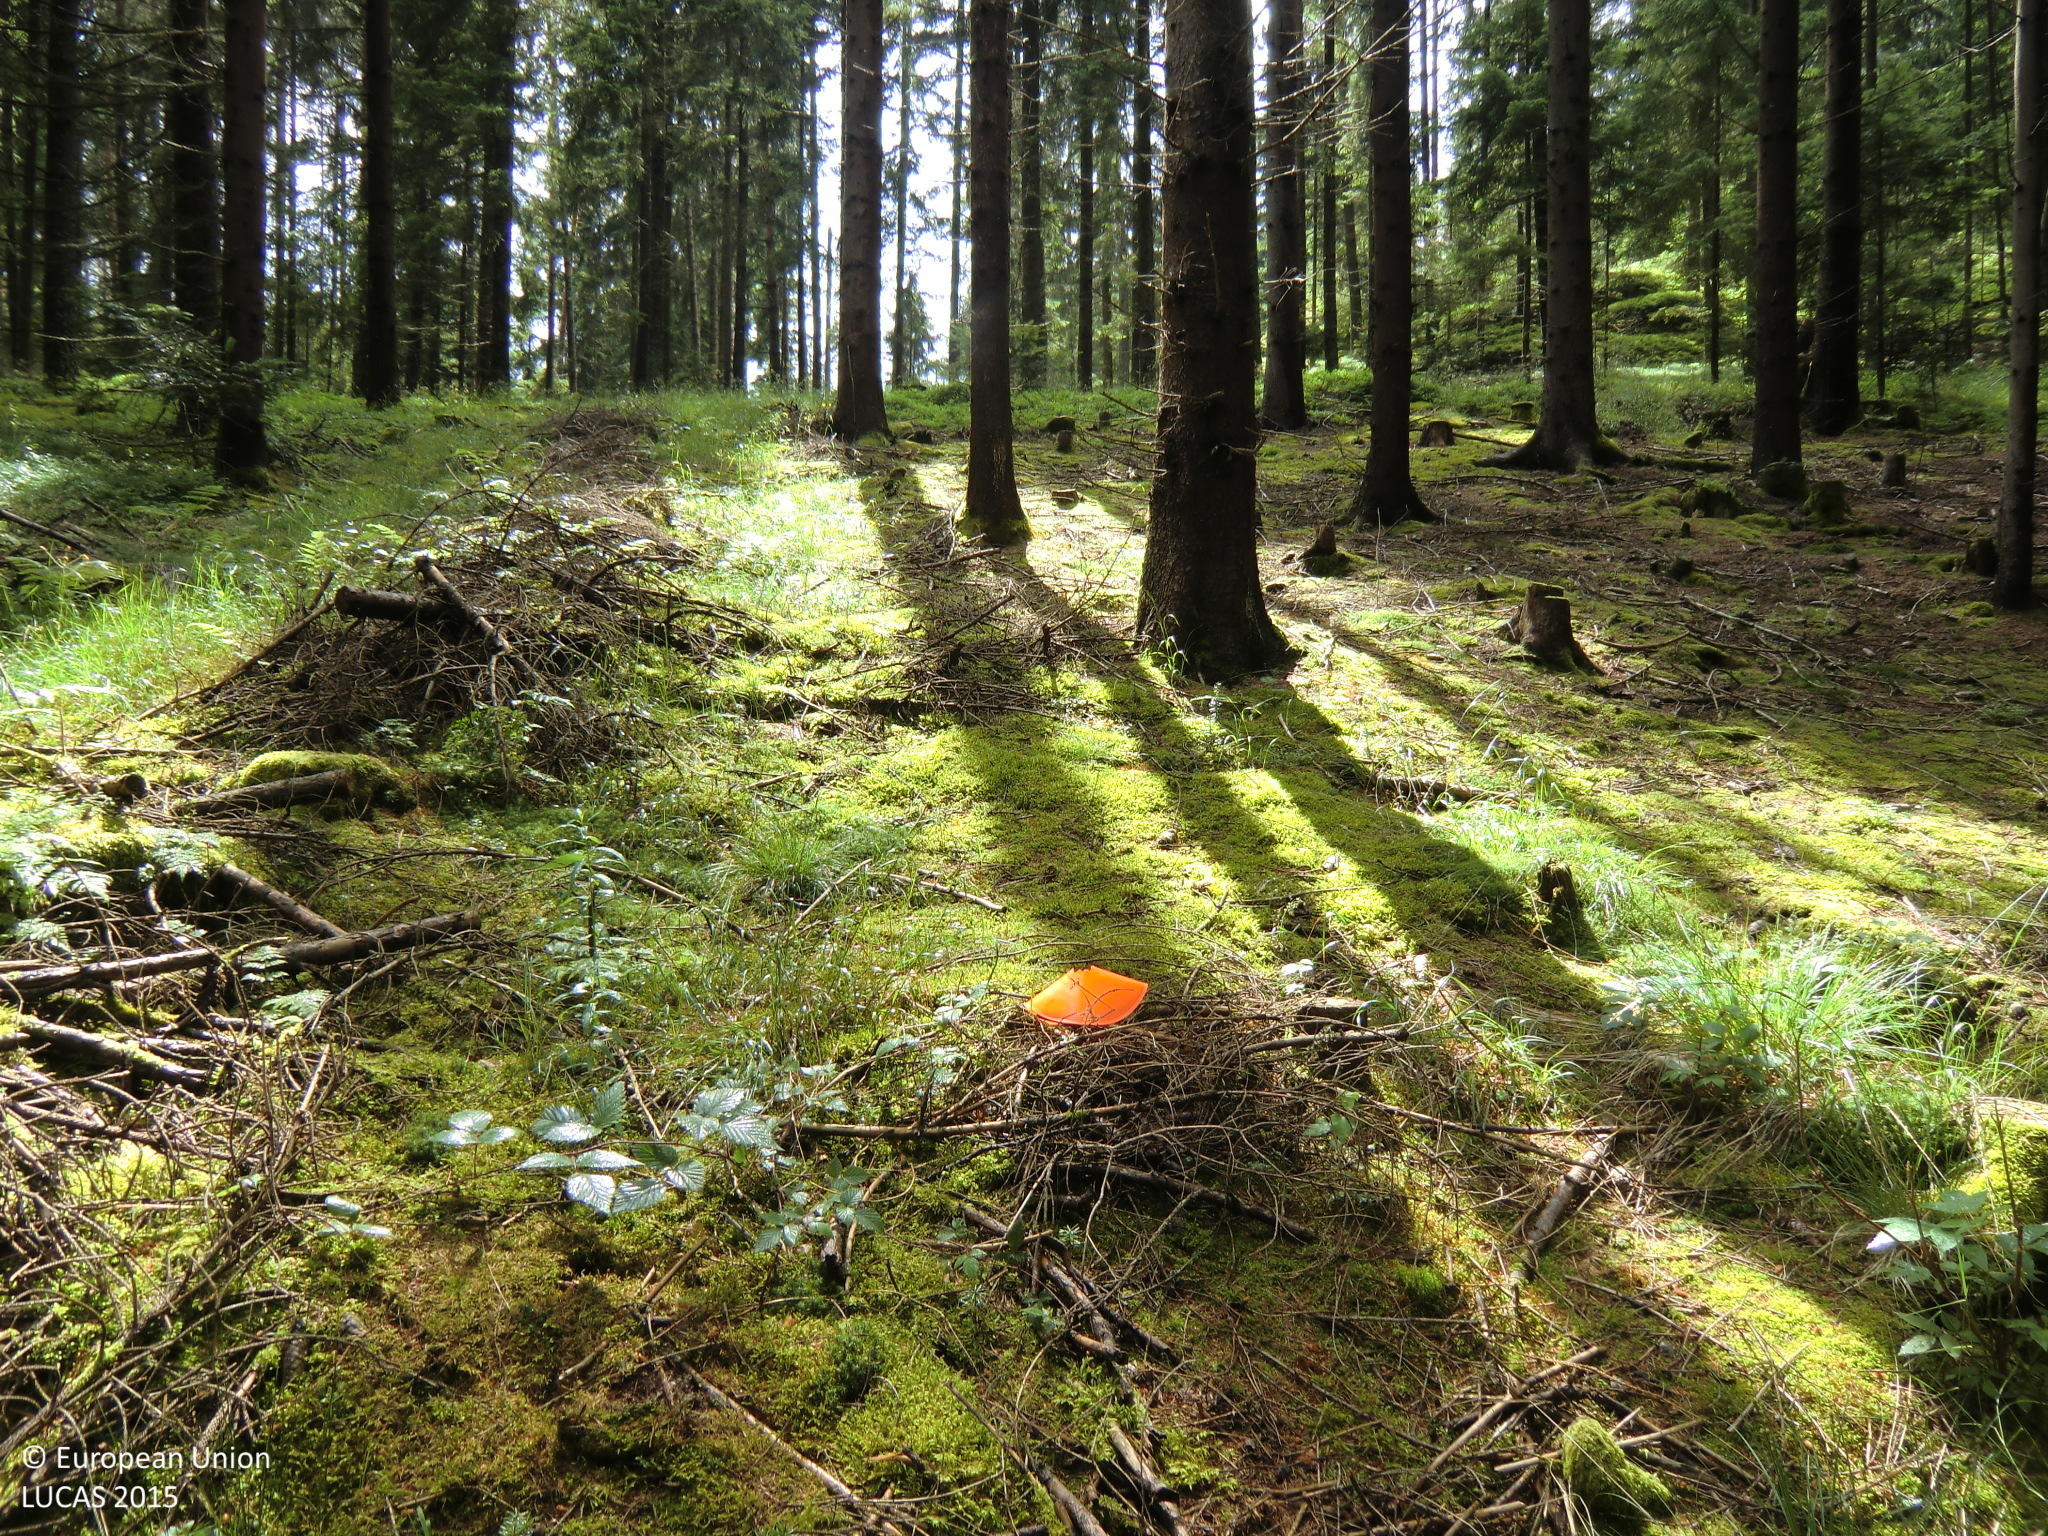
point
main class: Woodland
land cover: Spruce dominated coniferous woodland
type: hemiboreal forest and nemoral coniferous forest and mixed broadleaved-coniferous forest
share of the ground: > 75 %
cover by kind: coniferous forest trees 75 %, lichens and mosses 15 %, herbaceous plants 10 %
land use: Forestry
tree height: > 5 m
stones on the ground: 10 - 25 %
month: June
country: AT
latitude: 48.4302
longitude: 14.6907
